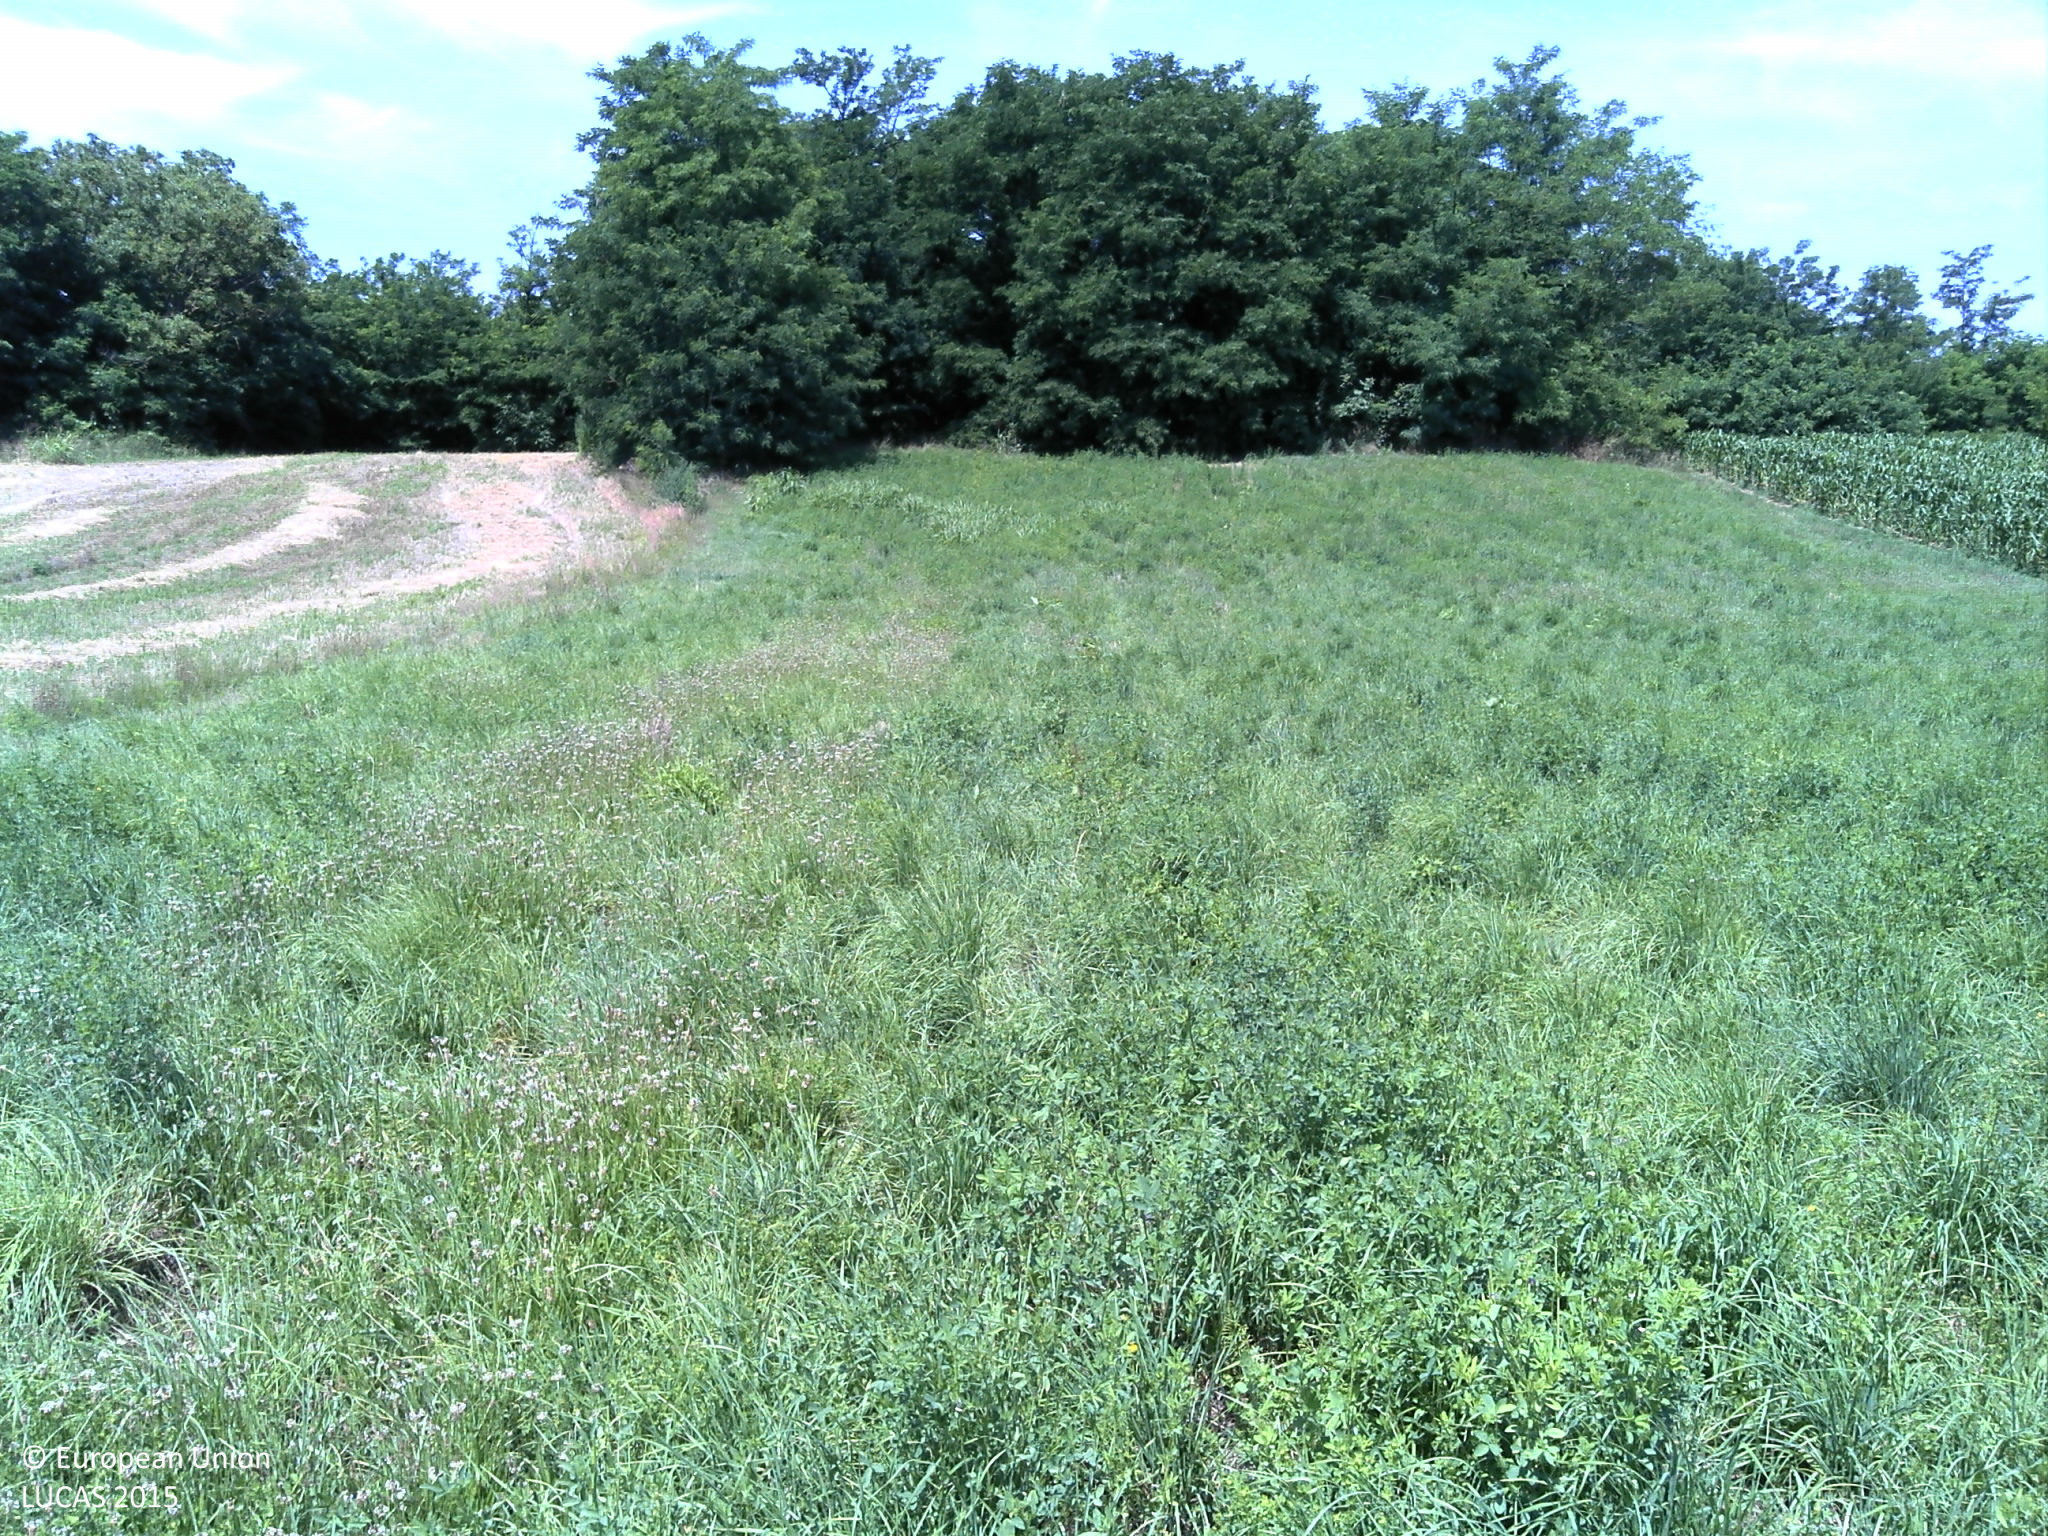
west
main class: Grassland
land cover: Spontaneously vegetated surfaces
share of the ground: > 75 %
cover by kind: herbaceous plants 100 %
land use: Semi-natural and natural areas not in use
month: June
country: HR
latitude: 45.9448
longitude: 17.2128
